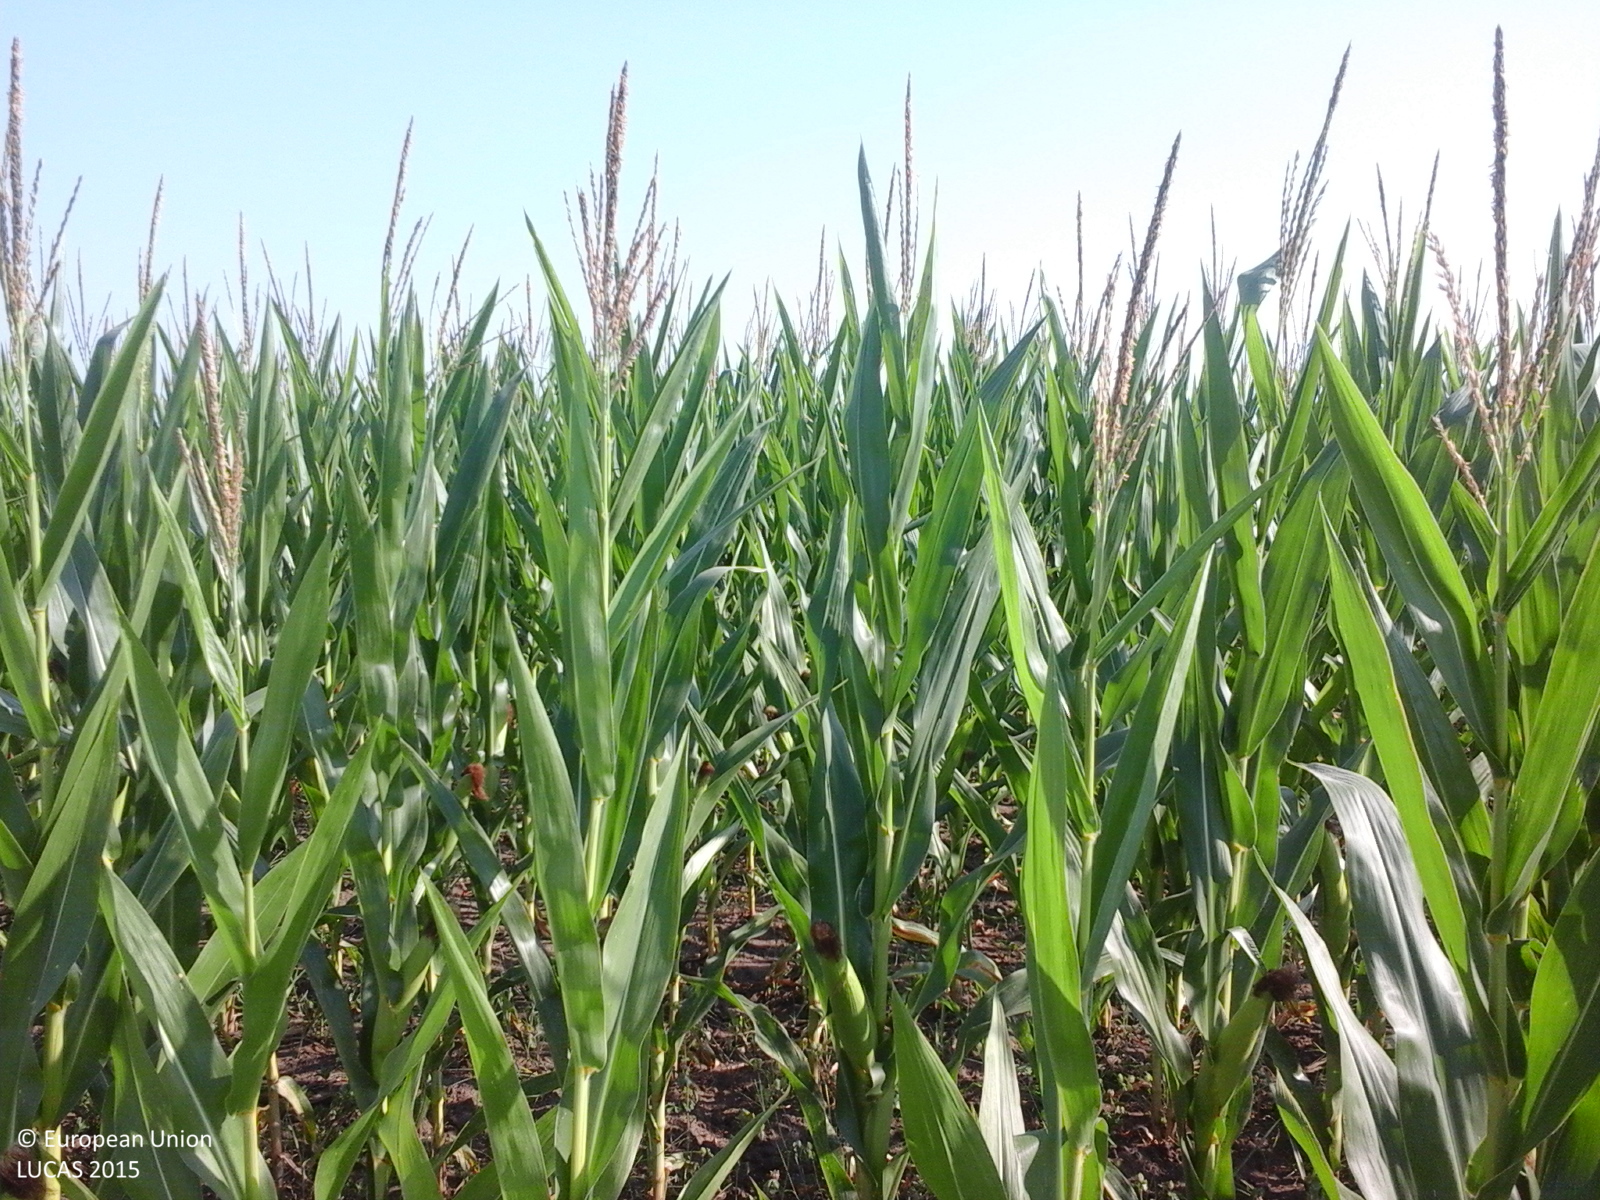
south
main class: Cropland
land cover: Maize
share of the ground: > 75 %
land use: Agriculture (excluding fallow land and kitchen gardens)
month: July
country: RO
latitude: 44.8943
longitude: 27.1690
